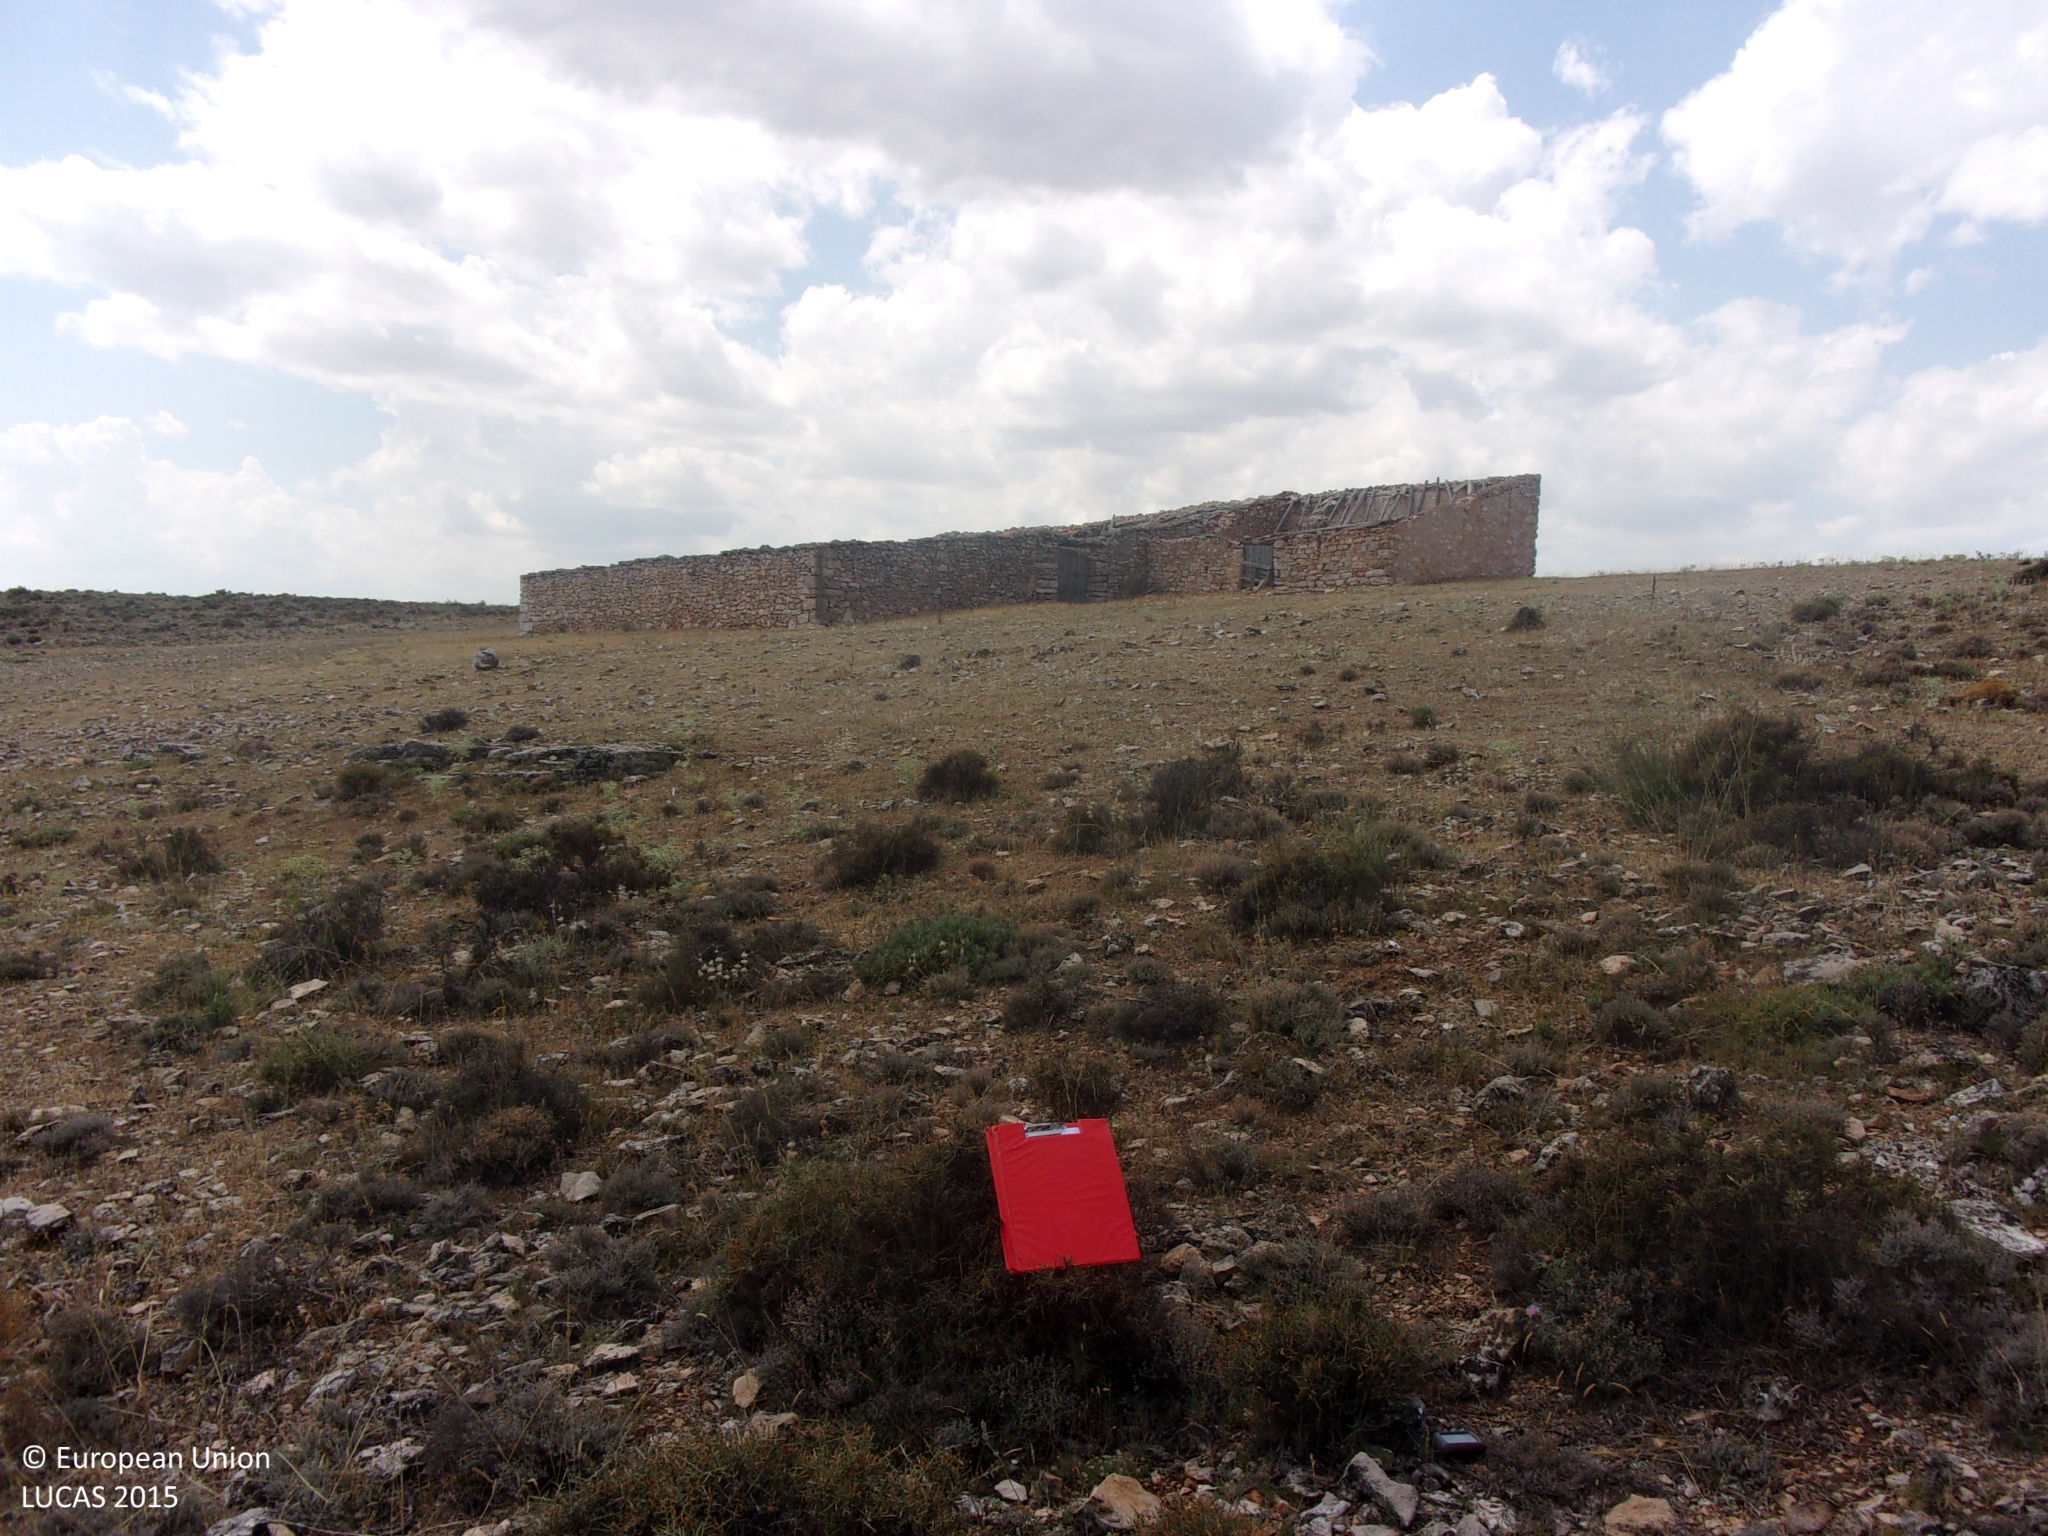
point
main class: Shrubland
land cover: Shrubland without tree cover
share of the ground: 50 - 75 %
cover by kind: consolidated bare surface 50 %, shrubs 40 %, herbaceous plants 10 %
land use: Semi-natural and natural areas not in use
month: July
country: ES
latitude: 41.1372
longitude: -1.8308
